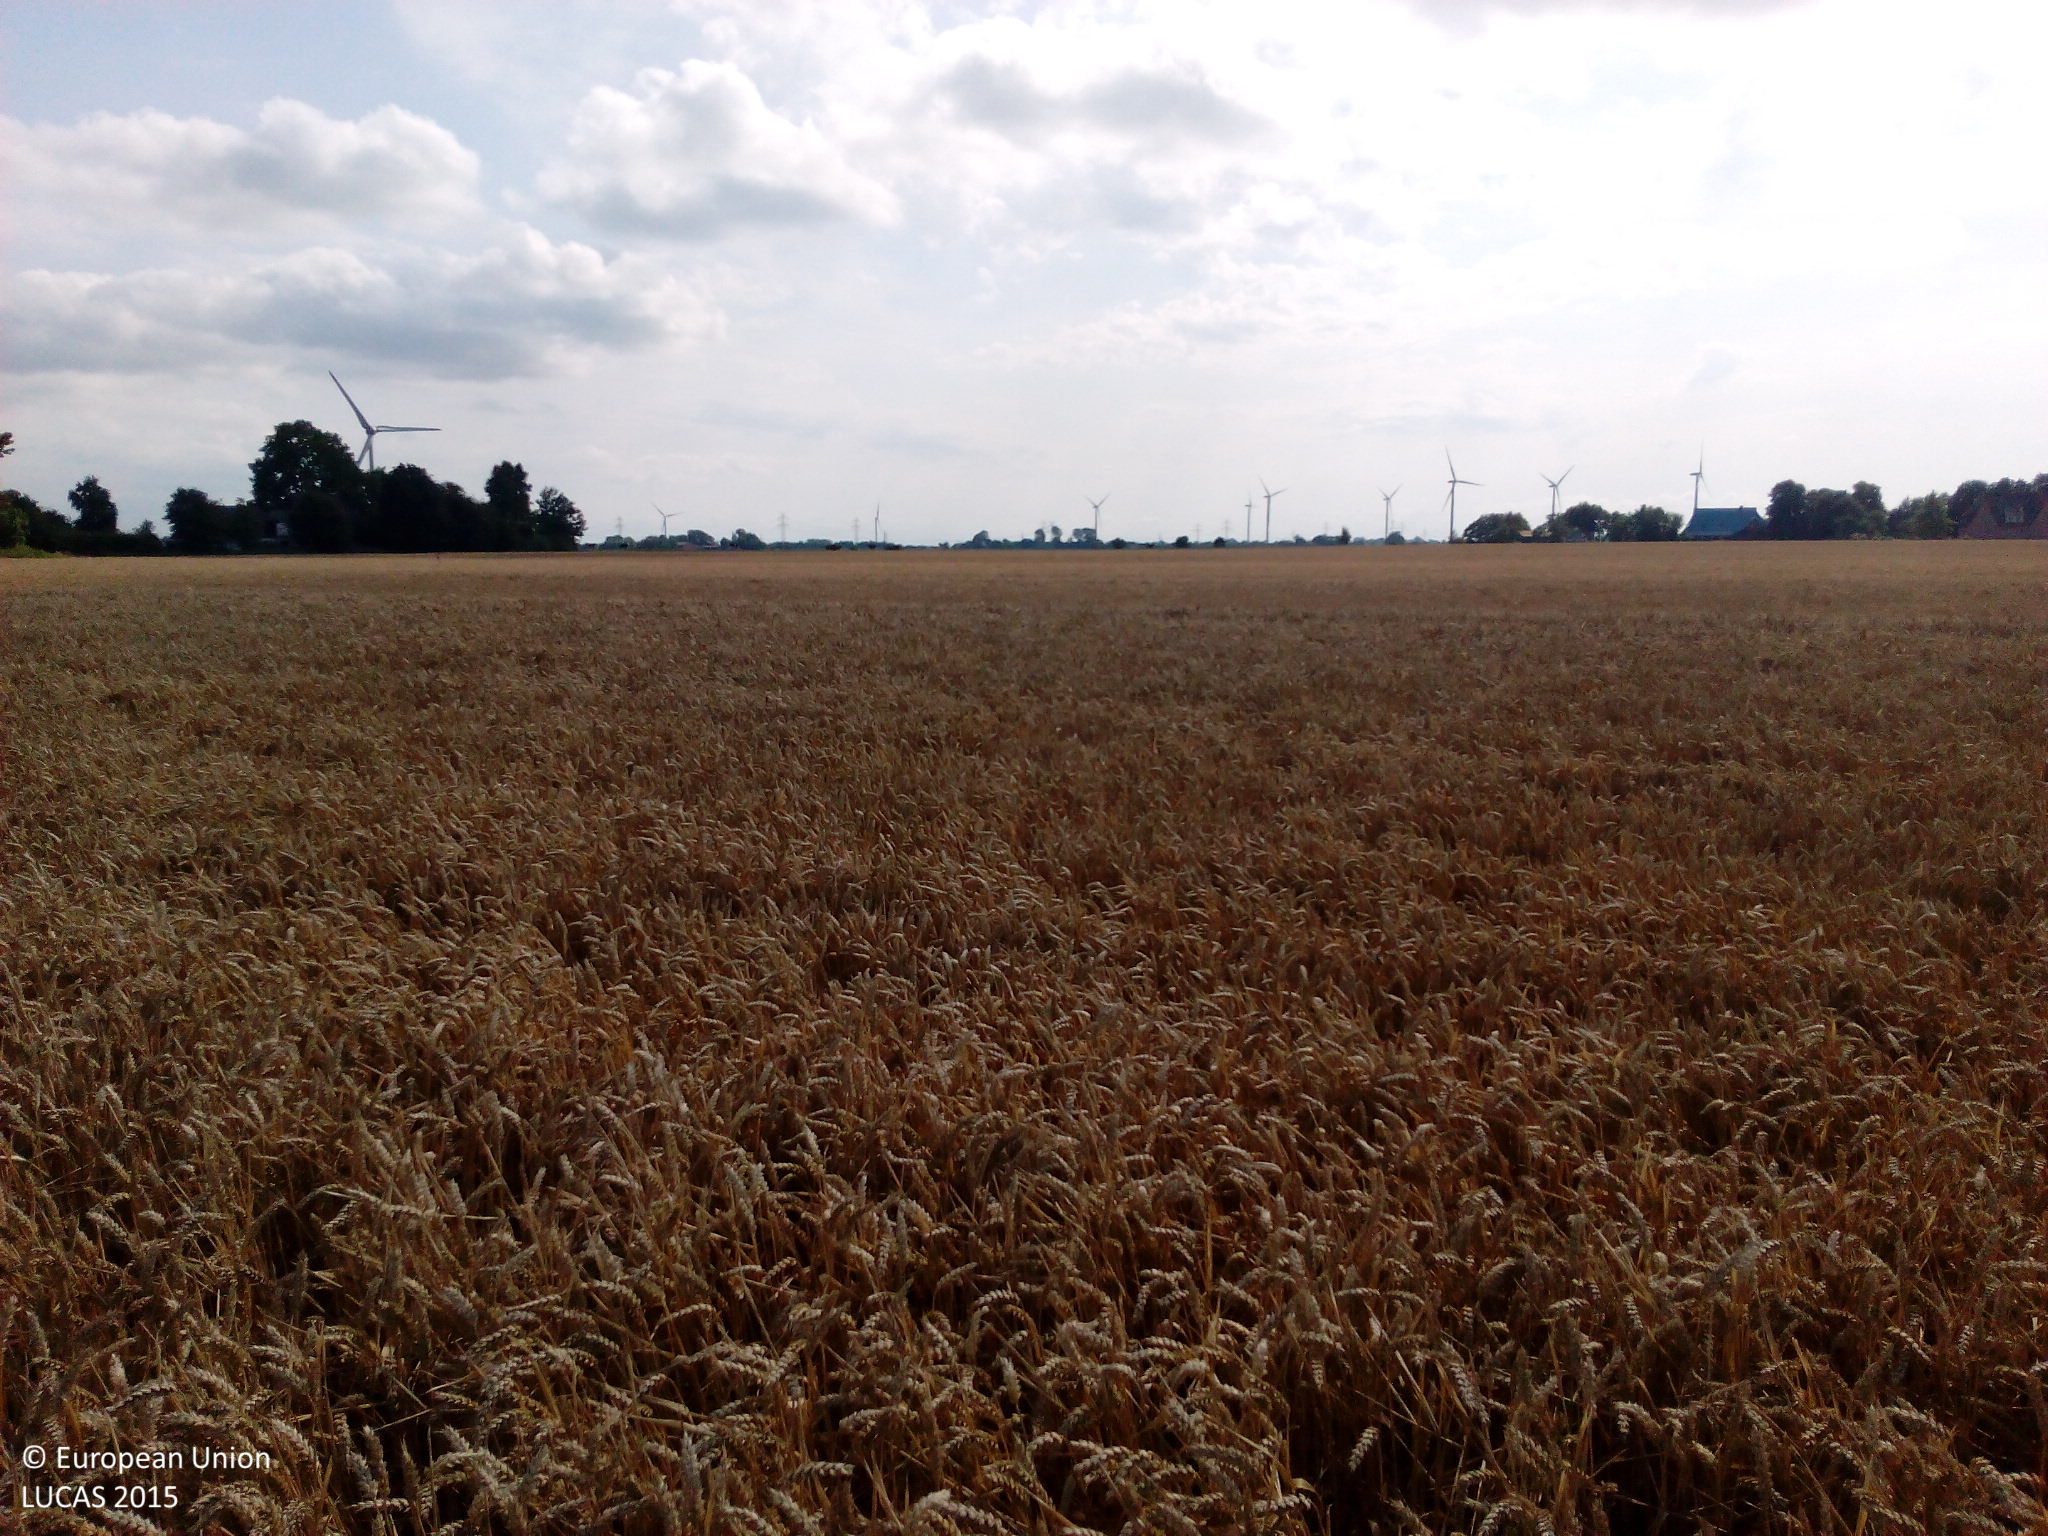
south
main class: Cropland
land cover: Common wheat
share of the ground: > 75 %
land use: Agriculture (excluding fallow land and kitchen gardens)
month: August
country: DE
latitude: 53.9392
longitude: 9.3149
